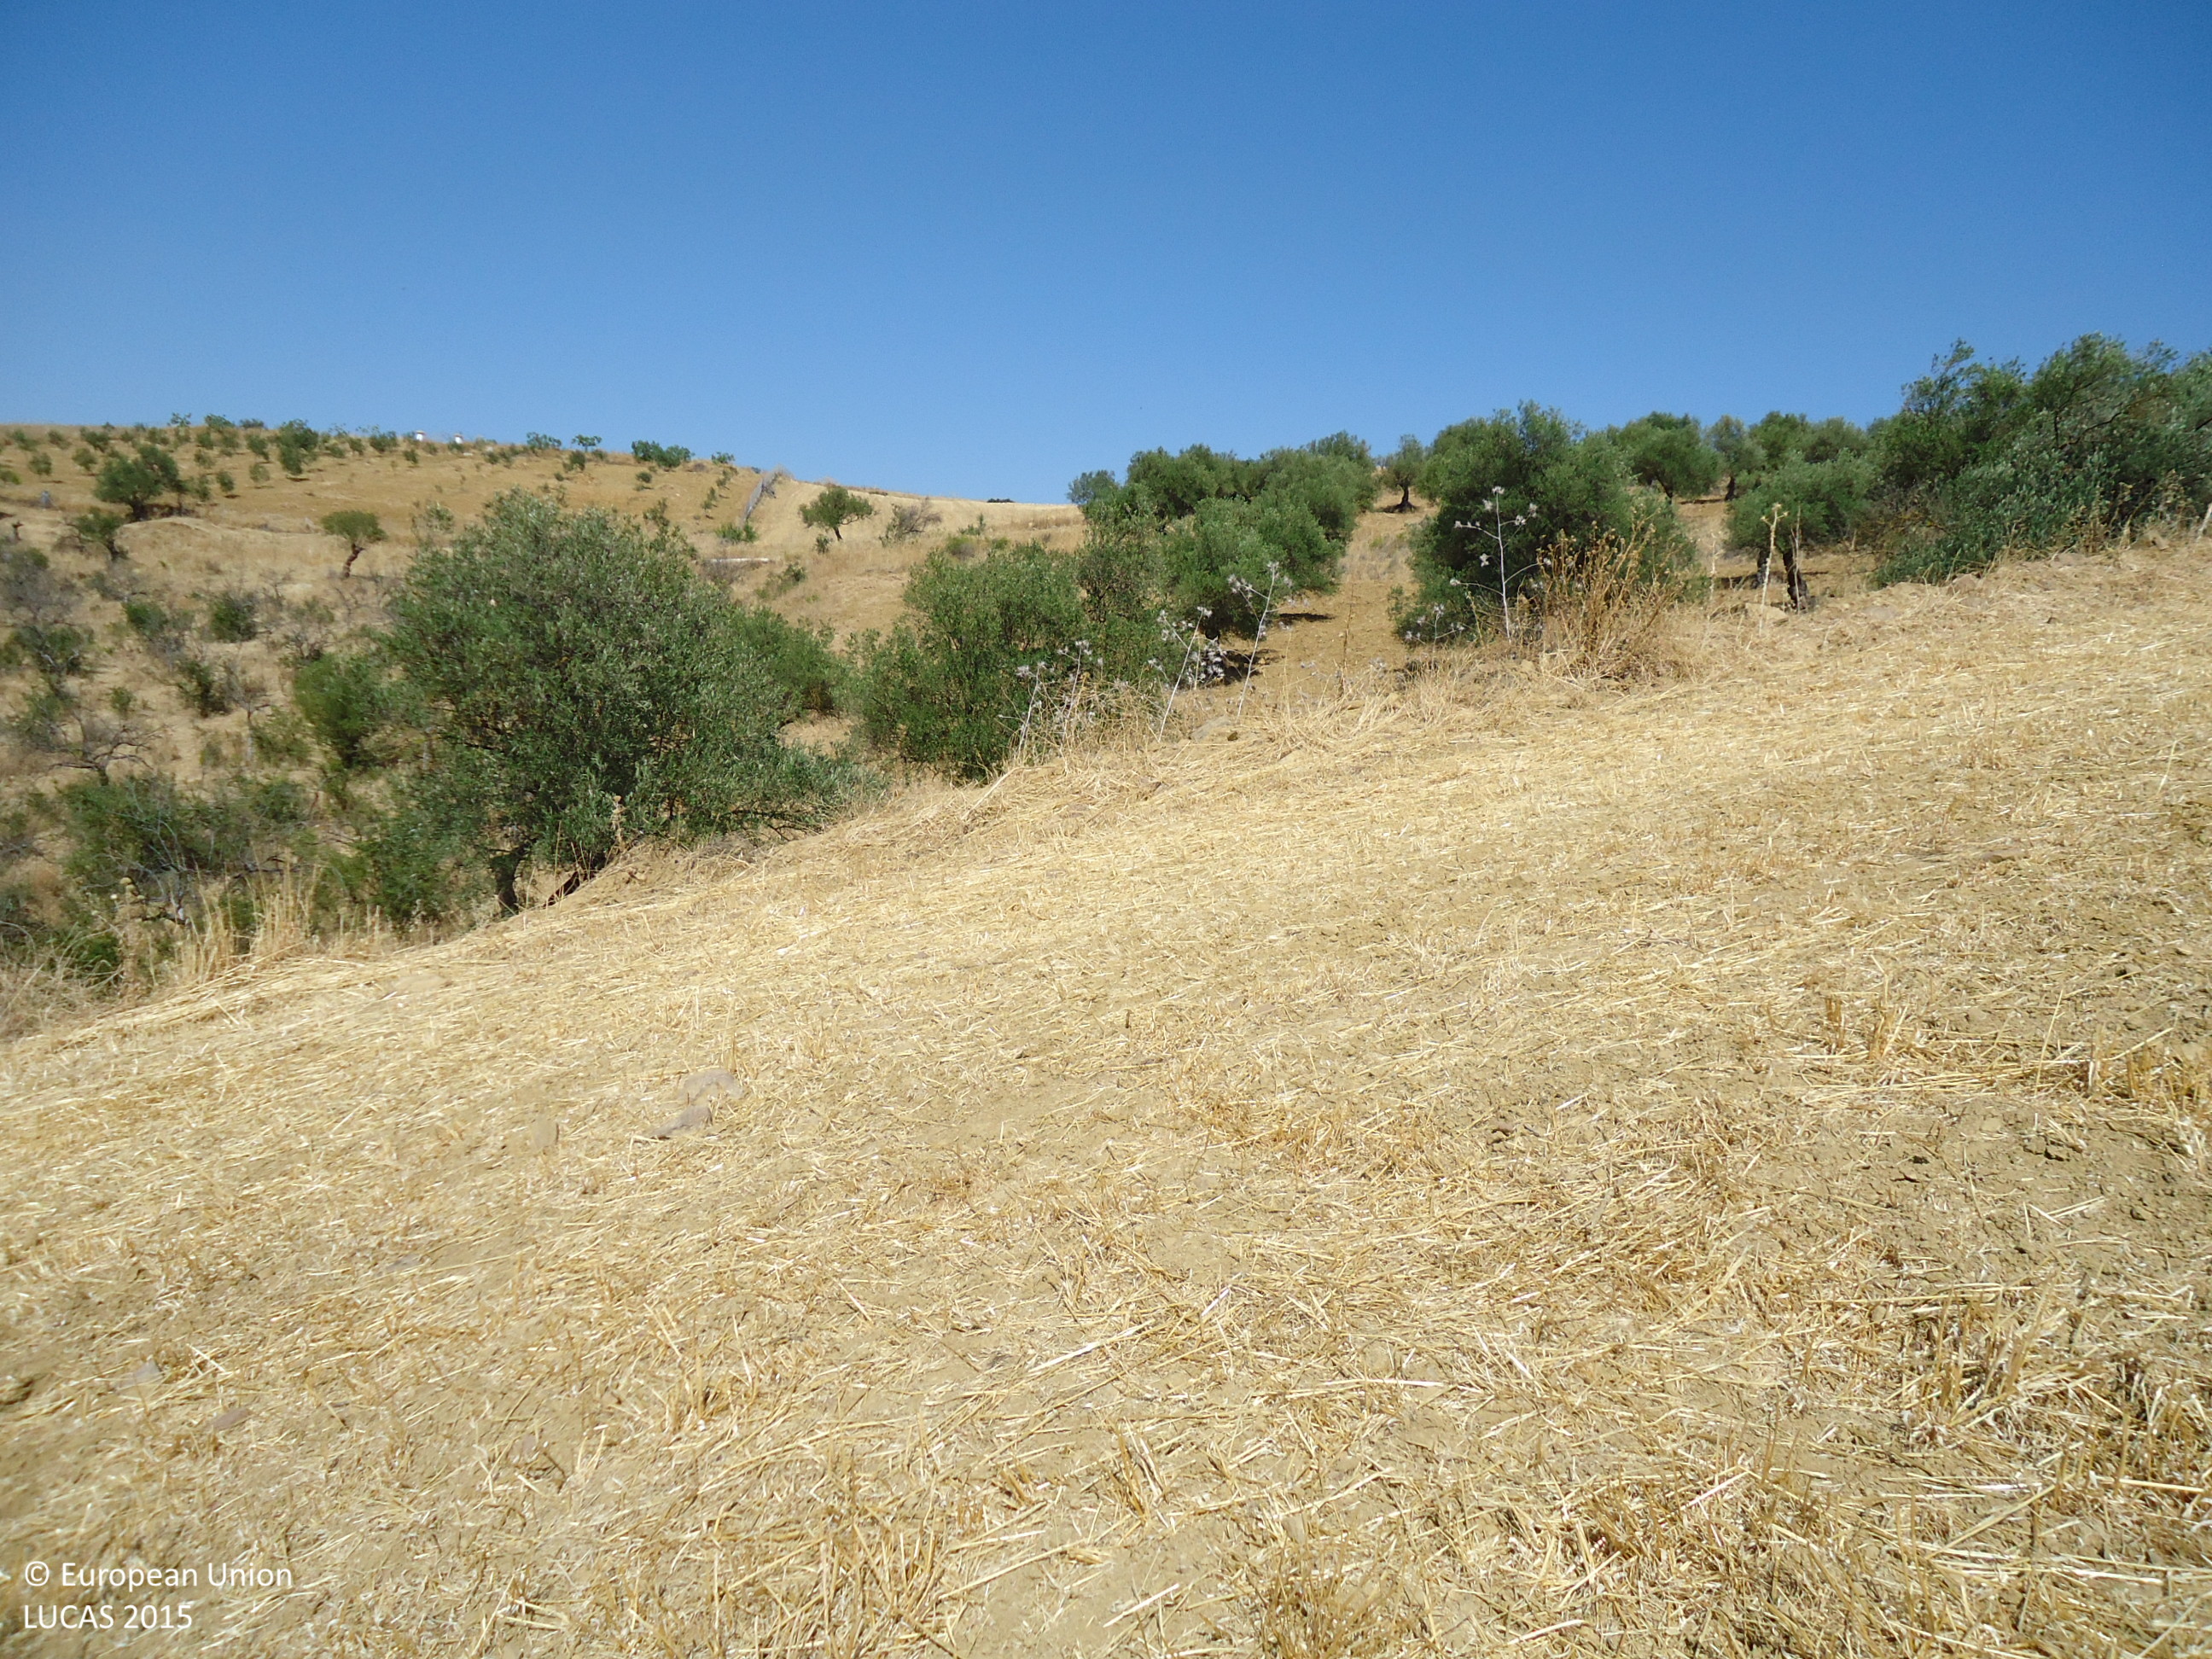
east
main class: Cropland
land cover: Durum wheat
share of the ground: < 10 %
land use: Agriculture (excluding fallow land and kitchen gardens)
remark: Harvested field
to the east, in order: Durum wheat; Olive groves; Grass margins; Olive groves; Grass margins; Durum wheat; Tracks; Oats; Grass margins; Oats
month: June
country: ES
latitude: 36.7210
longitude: -4.7389
